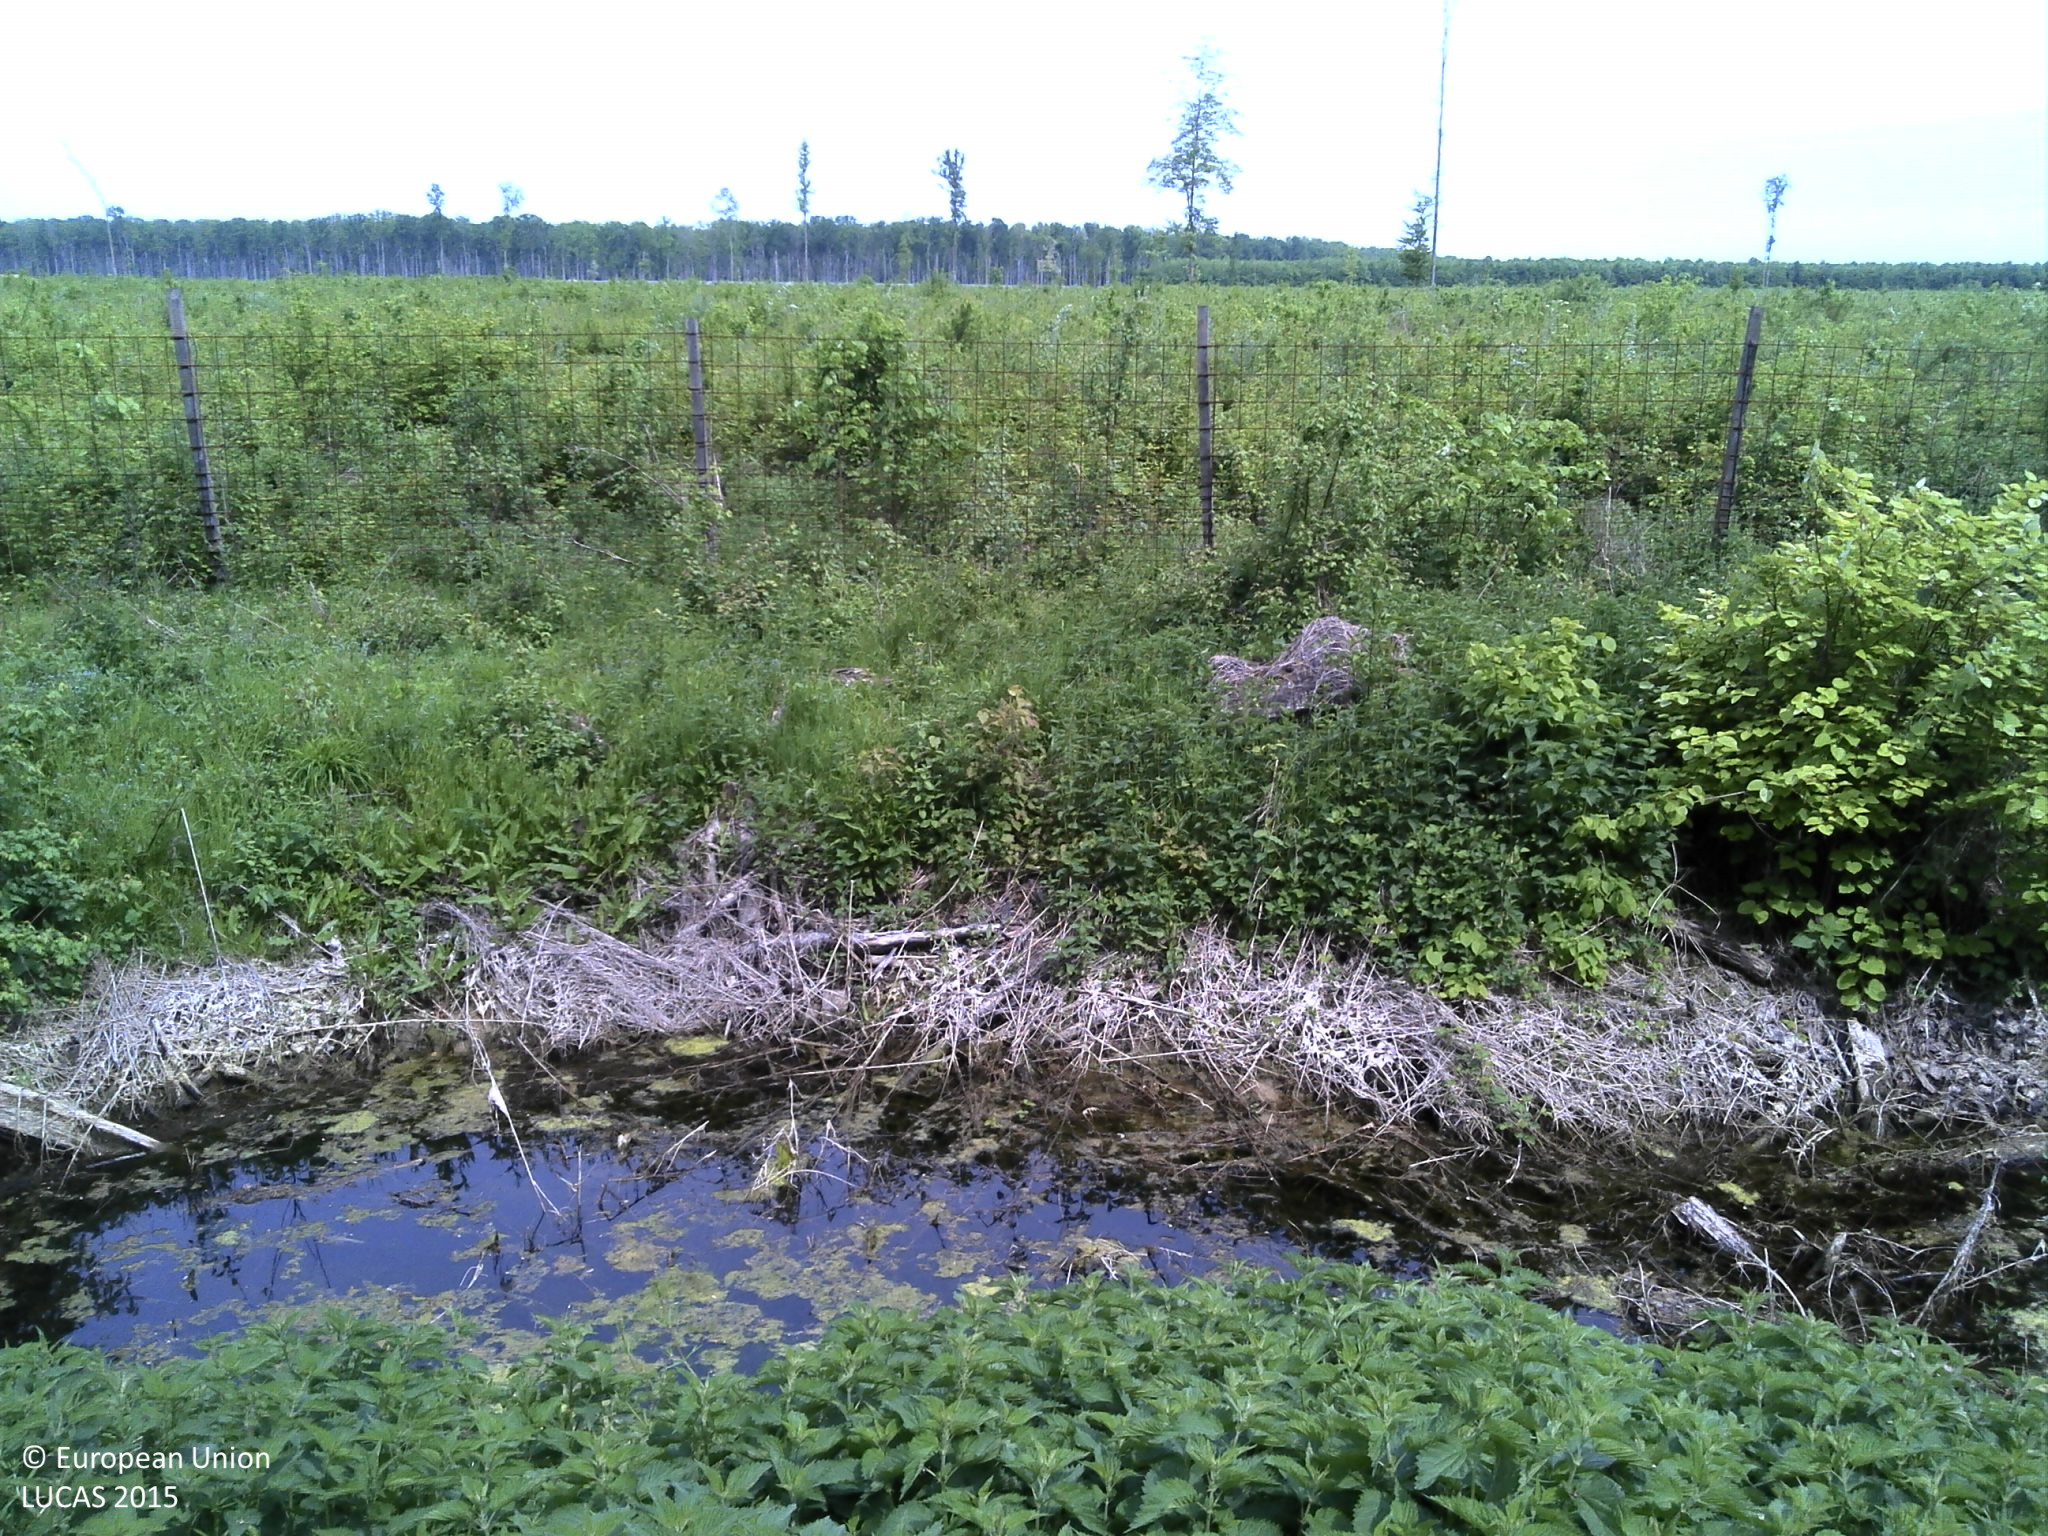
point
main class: Grassland
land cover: Spontaneously vegetated surfaces
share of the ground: > 75 %
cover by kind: herbaceous plants 65 %, unconsolidated bare surface 30 %, shrubs 5 %
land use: Forestry
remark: Clear cut
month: May
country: HR
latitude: 45.0390
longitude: 18.8800
